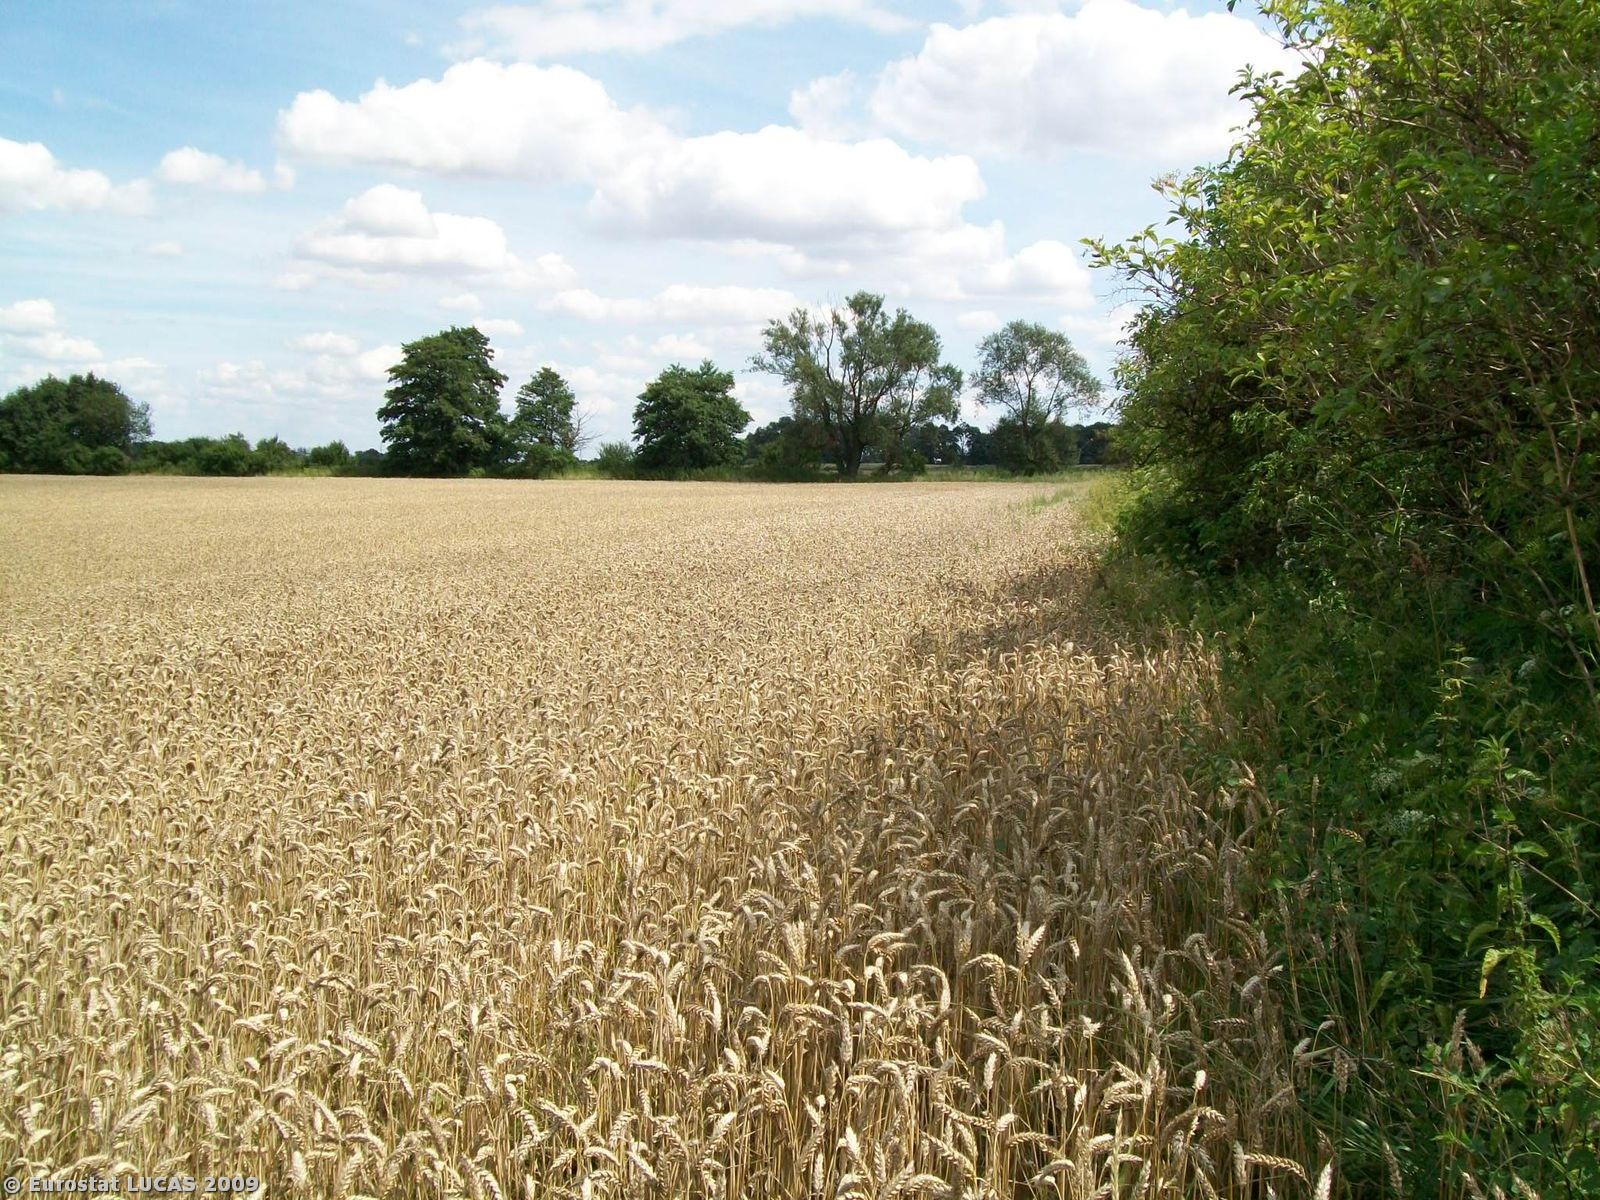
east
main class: Cropland
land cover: Common wheat
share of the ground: > 75 %
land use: Agriculture (excluding fallow land and kitchen gardens)
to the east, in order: Common wheat; Grass margins; Ditches and canals; Abandoned hedges; Common wheat; Rape and turnip rape
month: July
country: PL
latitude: 51.1563
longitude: 16.1115
